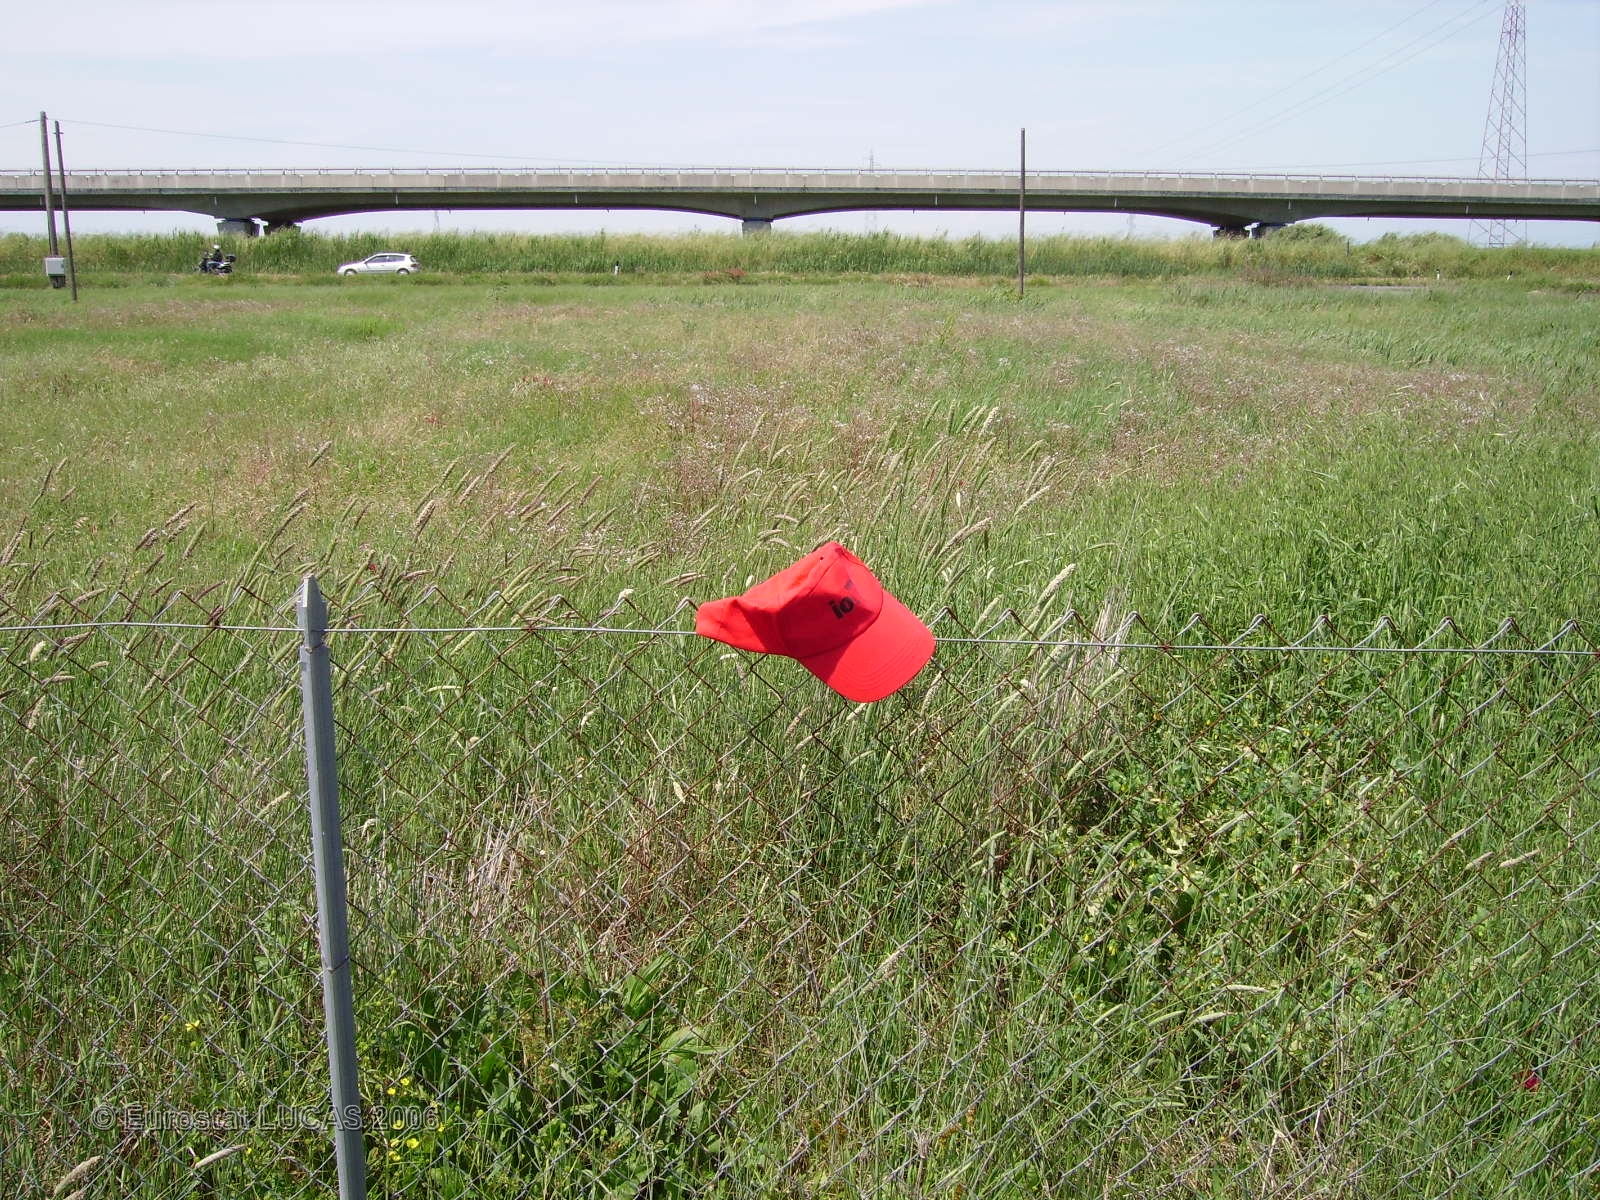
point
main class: Grassland
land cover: Grassland without tree/shrub cover
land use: Agriculture (excluding fallow land and kitchen gardens)
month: May
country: IT
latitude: 43.6101
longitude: 10.3830
